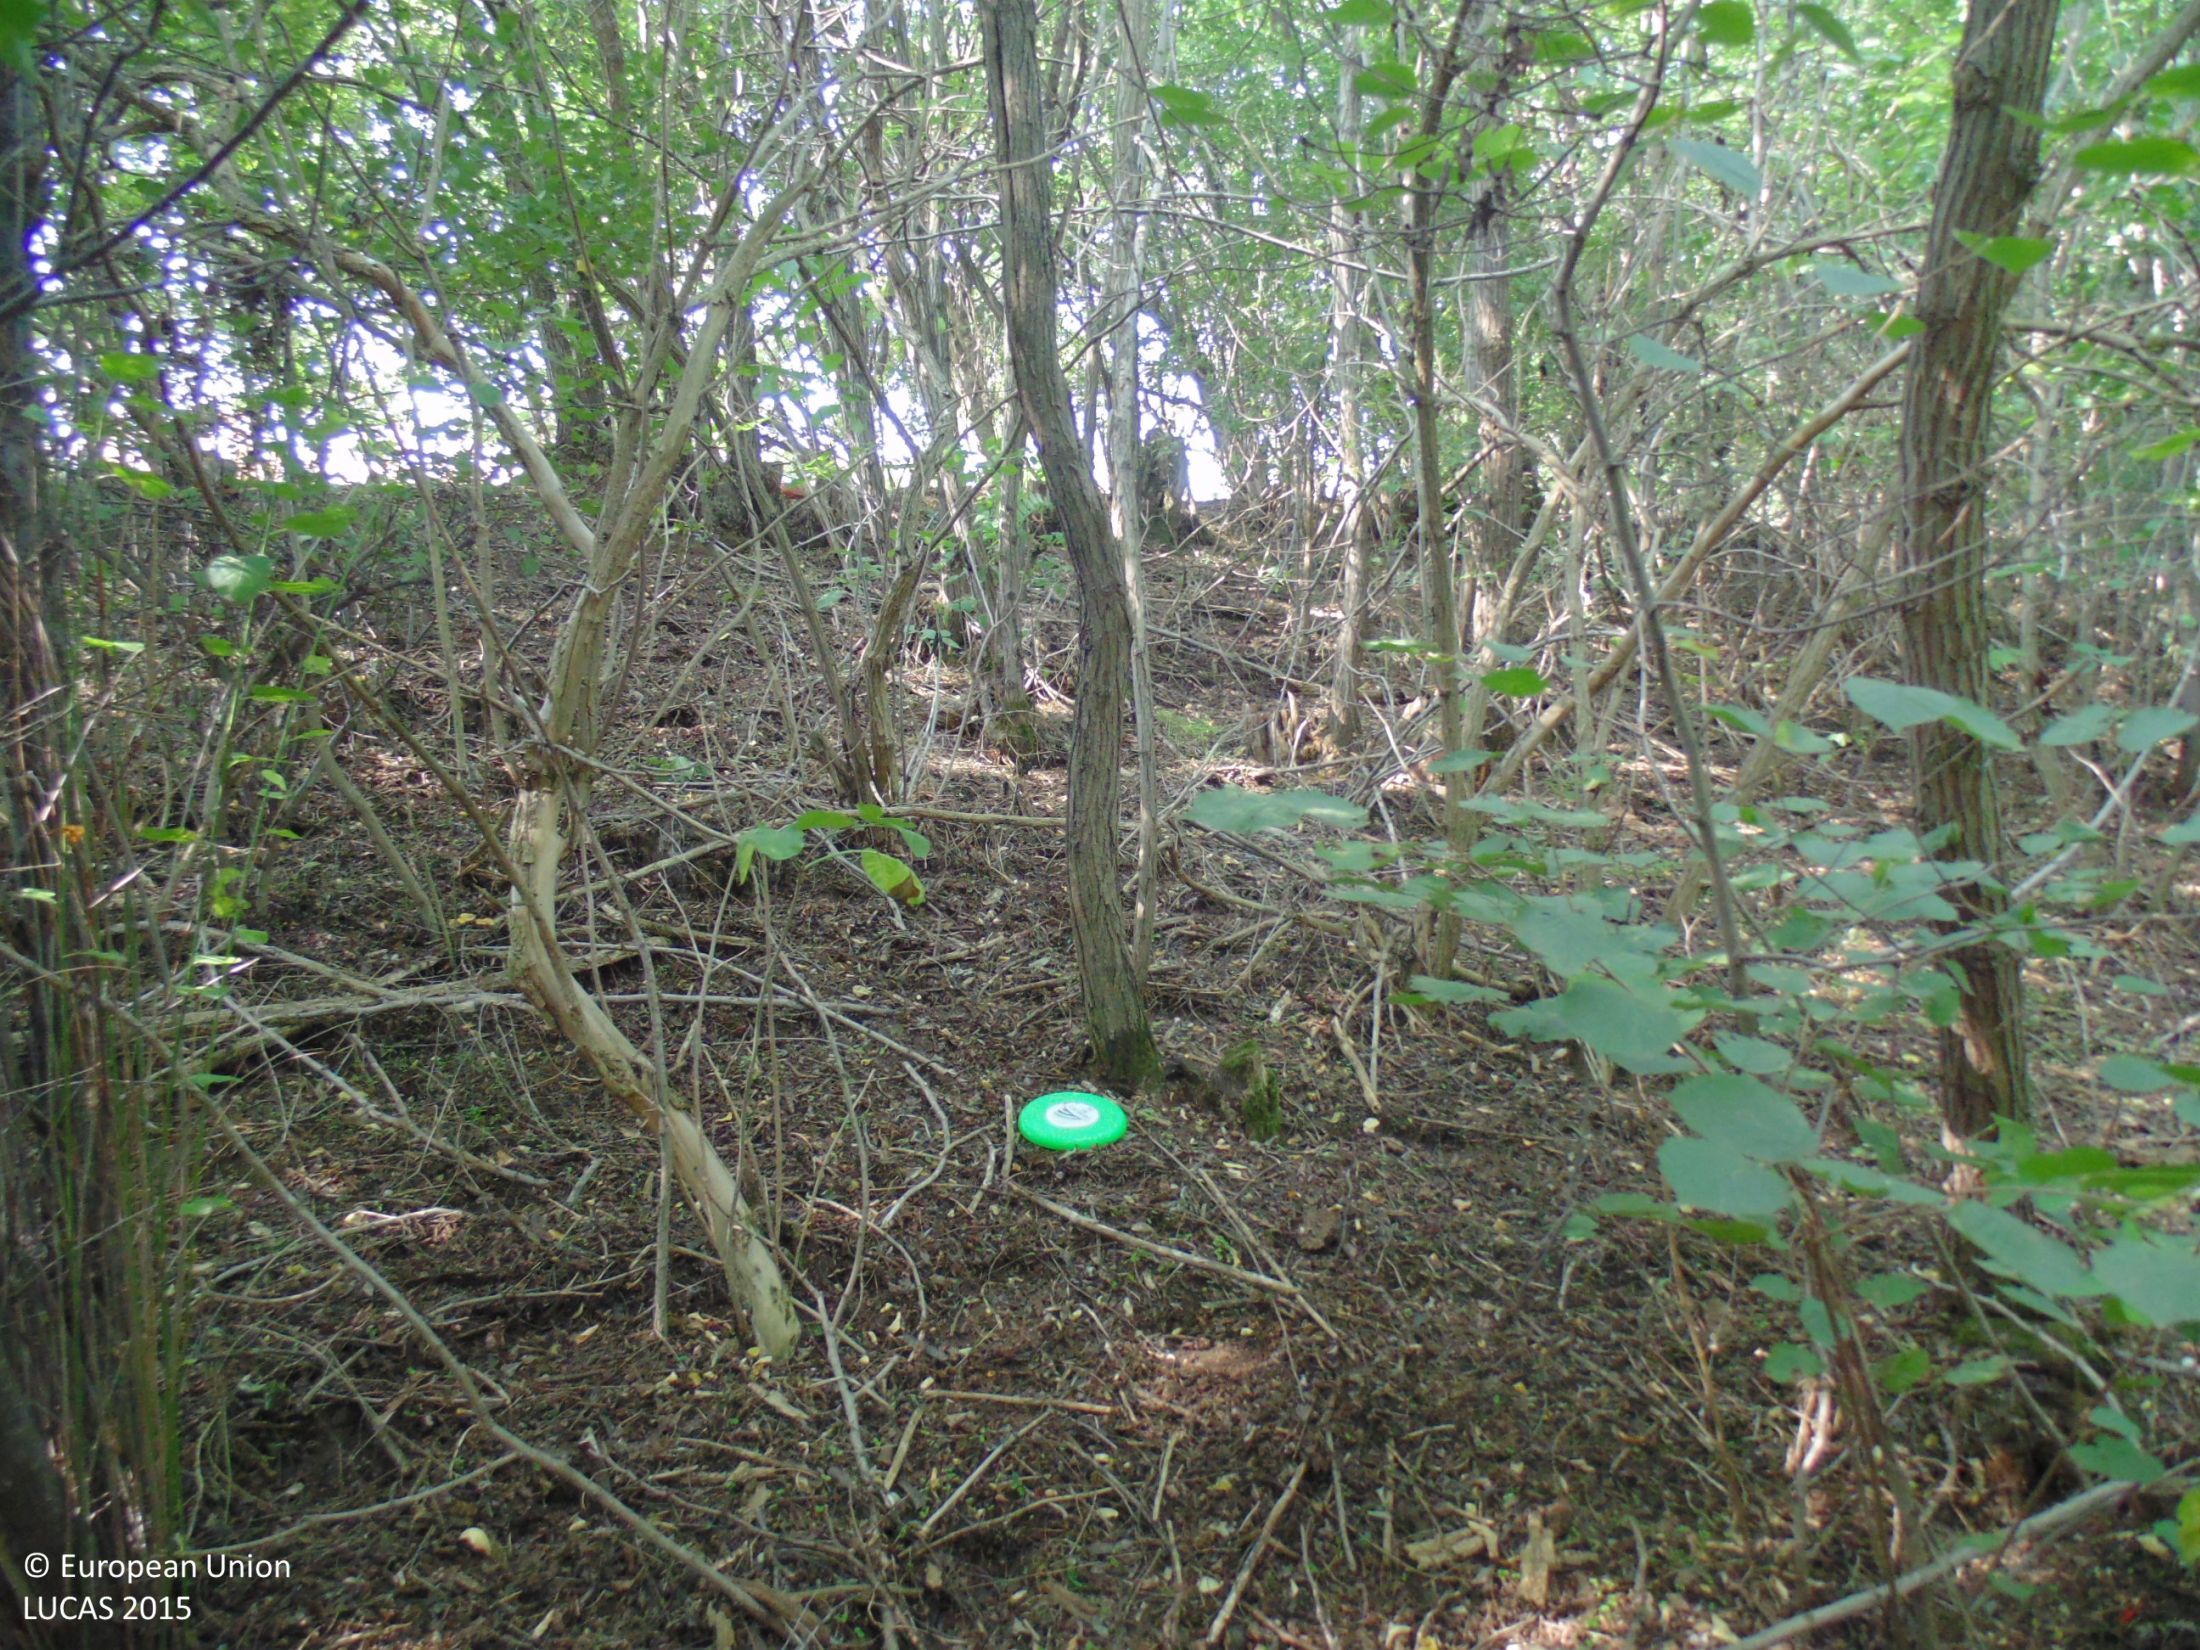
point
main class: Woodland
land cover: Broadleaved woodland
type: mesophytic deciduous forest
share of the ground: > 75 %
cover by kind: broadleaved forest trees 95 %, herbaceous plants 5 %
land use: Forestry
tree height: > 5 m
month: August
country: BG
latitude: 44.0545
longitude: 27.3465
